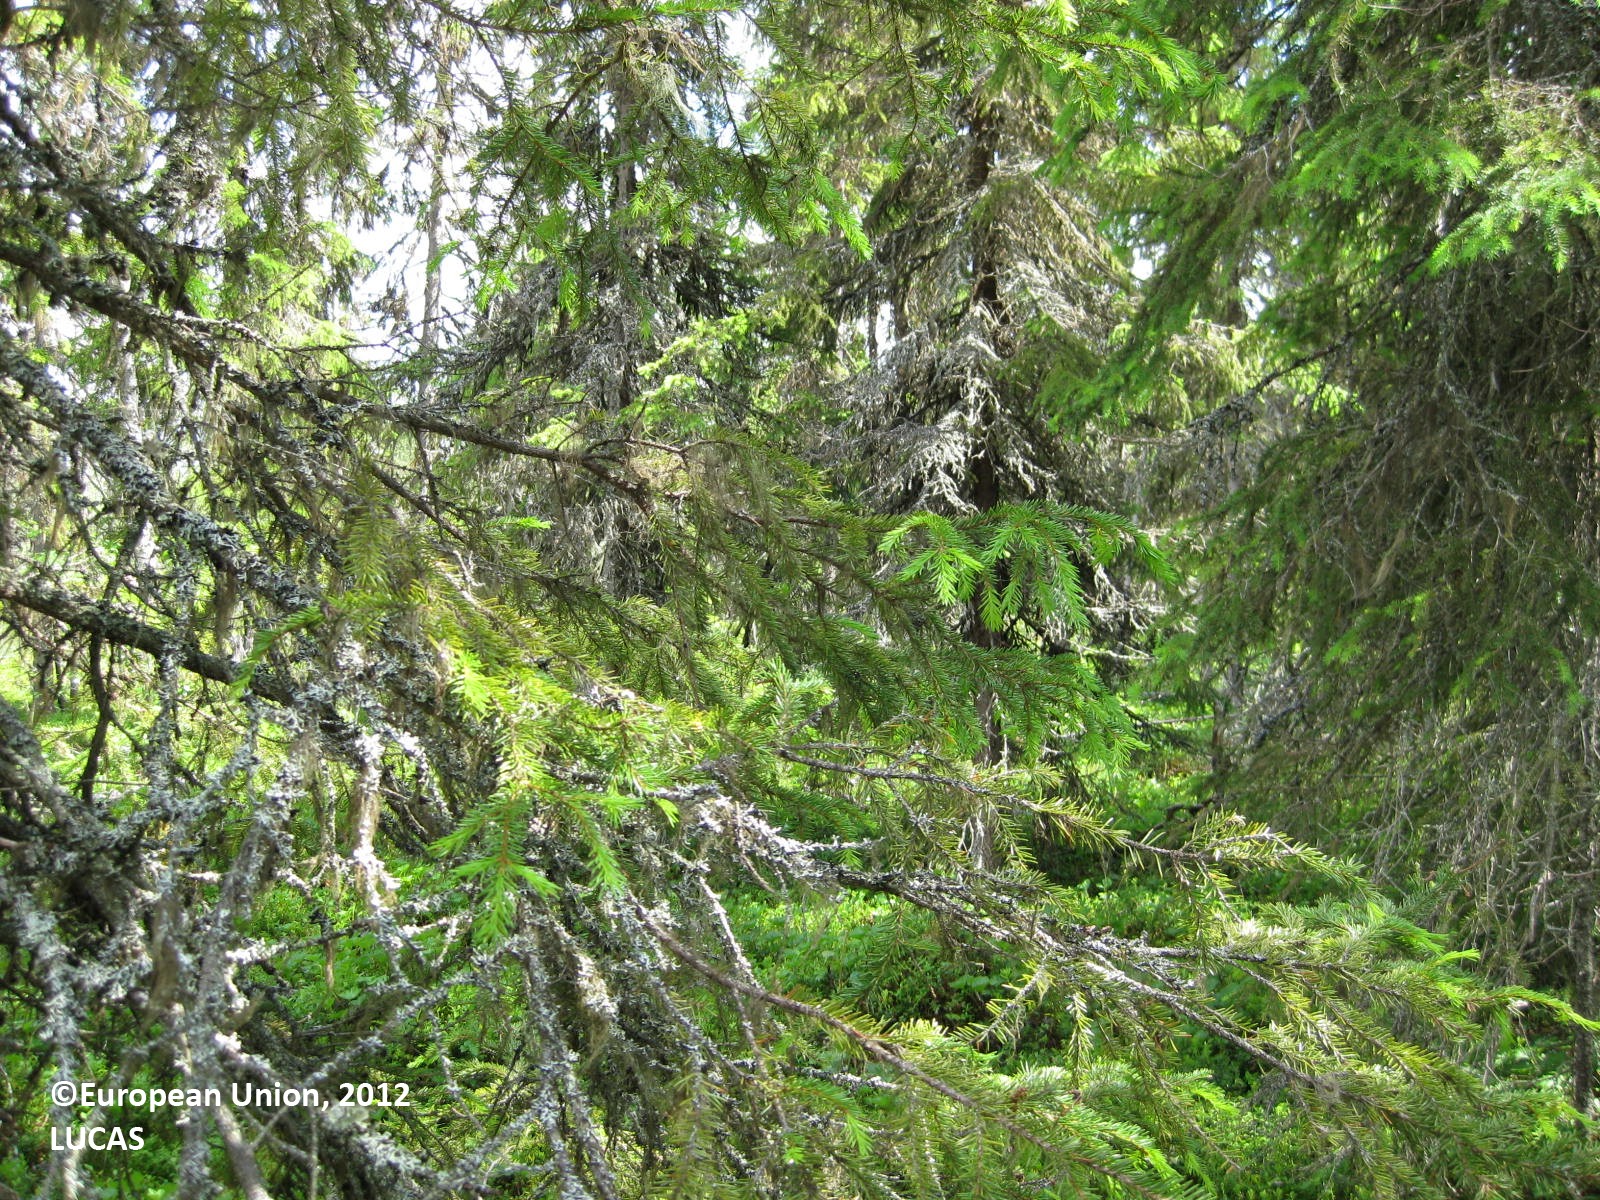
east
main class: Woodland
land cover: Spruce dominated coniferous woodland
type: boreal forest
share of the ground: > 75 %
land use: Forestry
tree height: > 5 m
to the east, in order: Spruce dominated coniferous woodland; Pine dominated coniferous woodland; Other coniferous woodland; Ditches and canals; Spruce dominated mixed woodland; Ditches and canals; Spruce dominated mixed woodland; Ditches and canals; Spruce dominated mixed woodland; Pine dominated coniferous woodland; Pine dominated mixed woodland
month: July
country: FI
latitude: 65.6379
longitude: 29.5561
